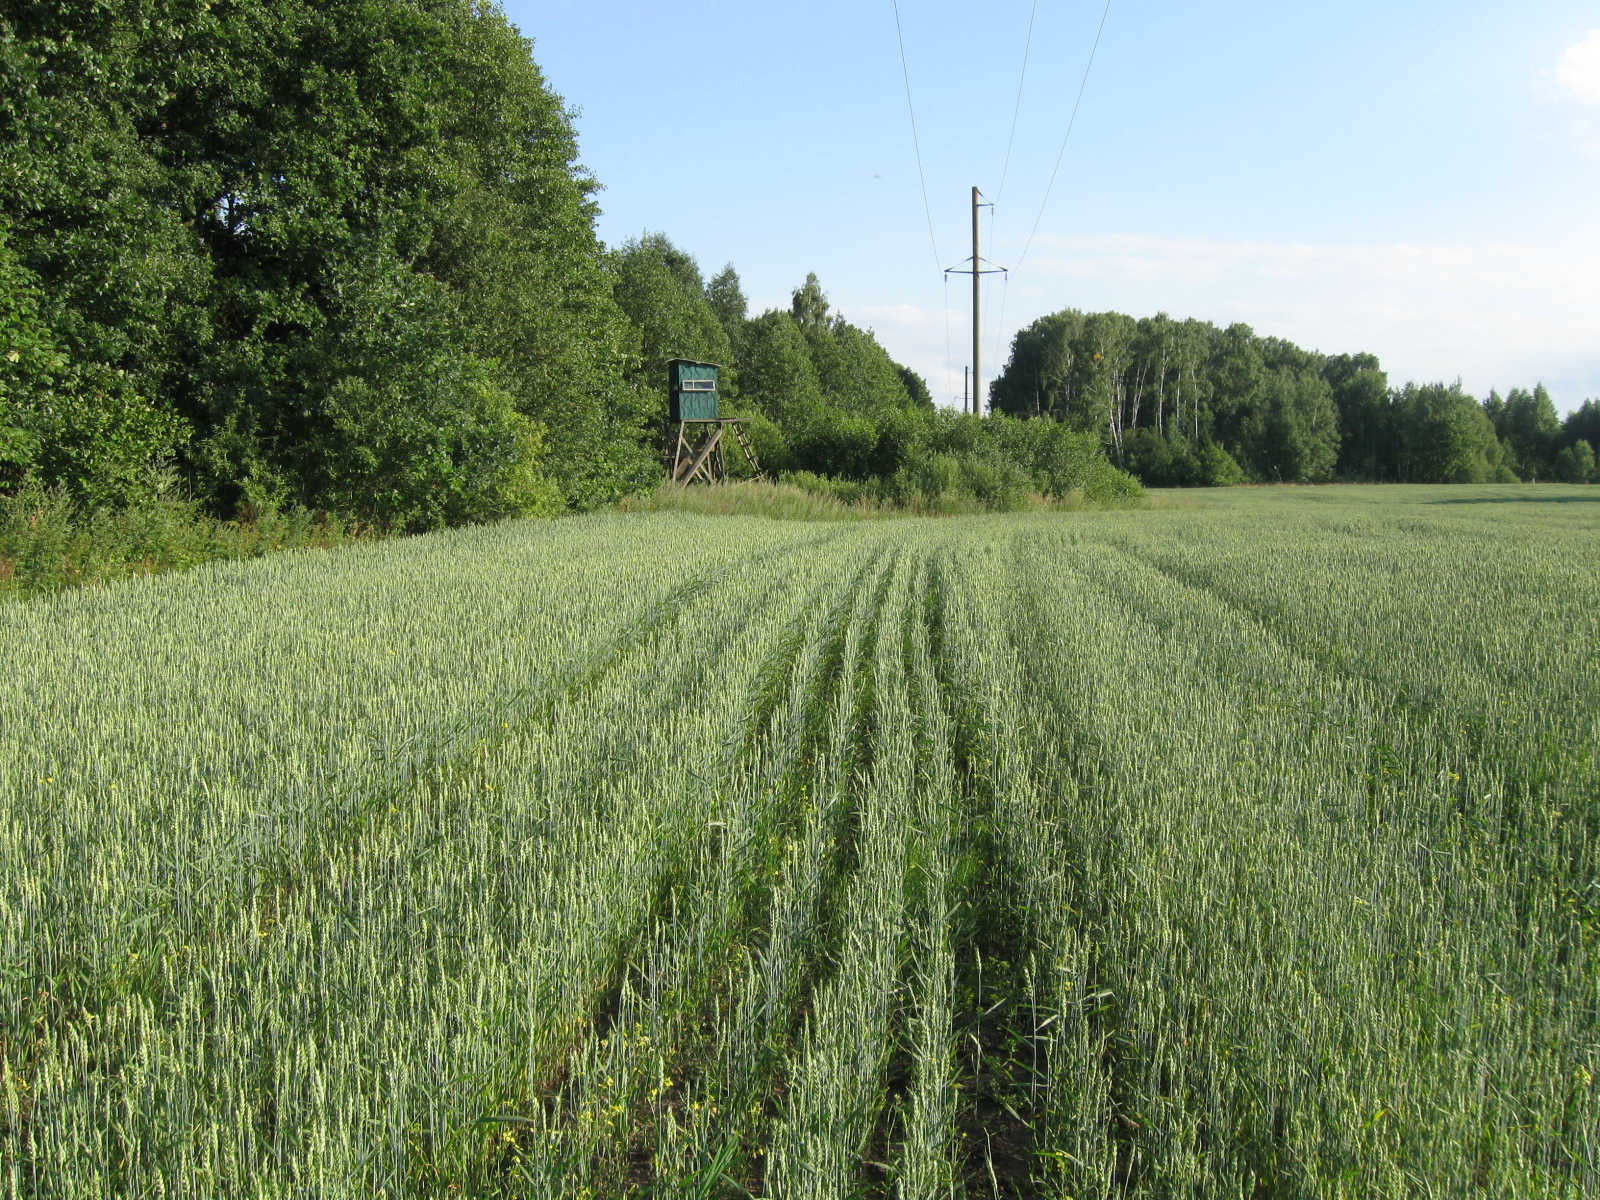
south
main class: Cropland
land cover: Common wheat
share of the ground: > 75 %
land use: Agriculture (excluding fallow land and kitchen gardens)
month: July
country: LT
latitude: 54.3571
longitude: 23.3277
